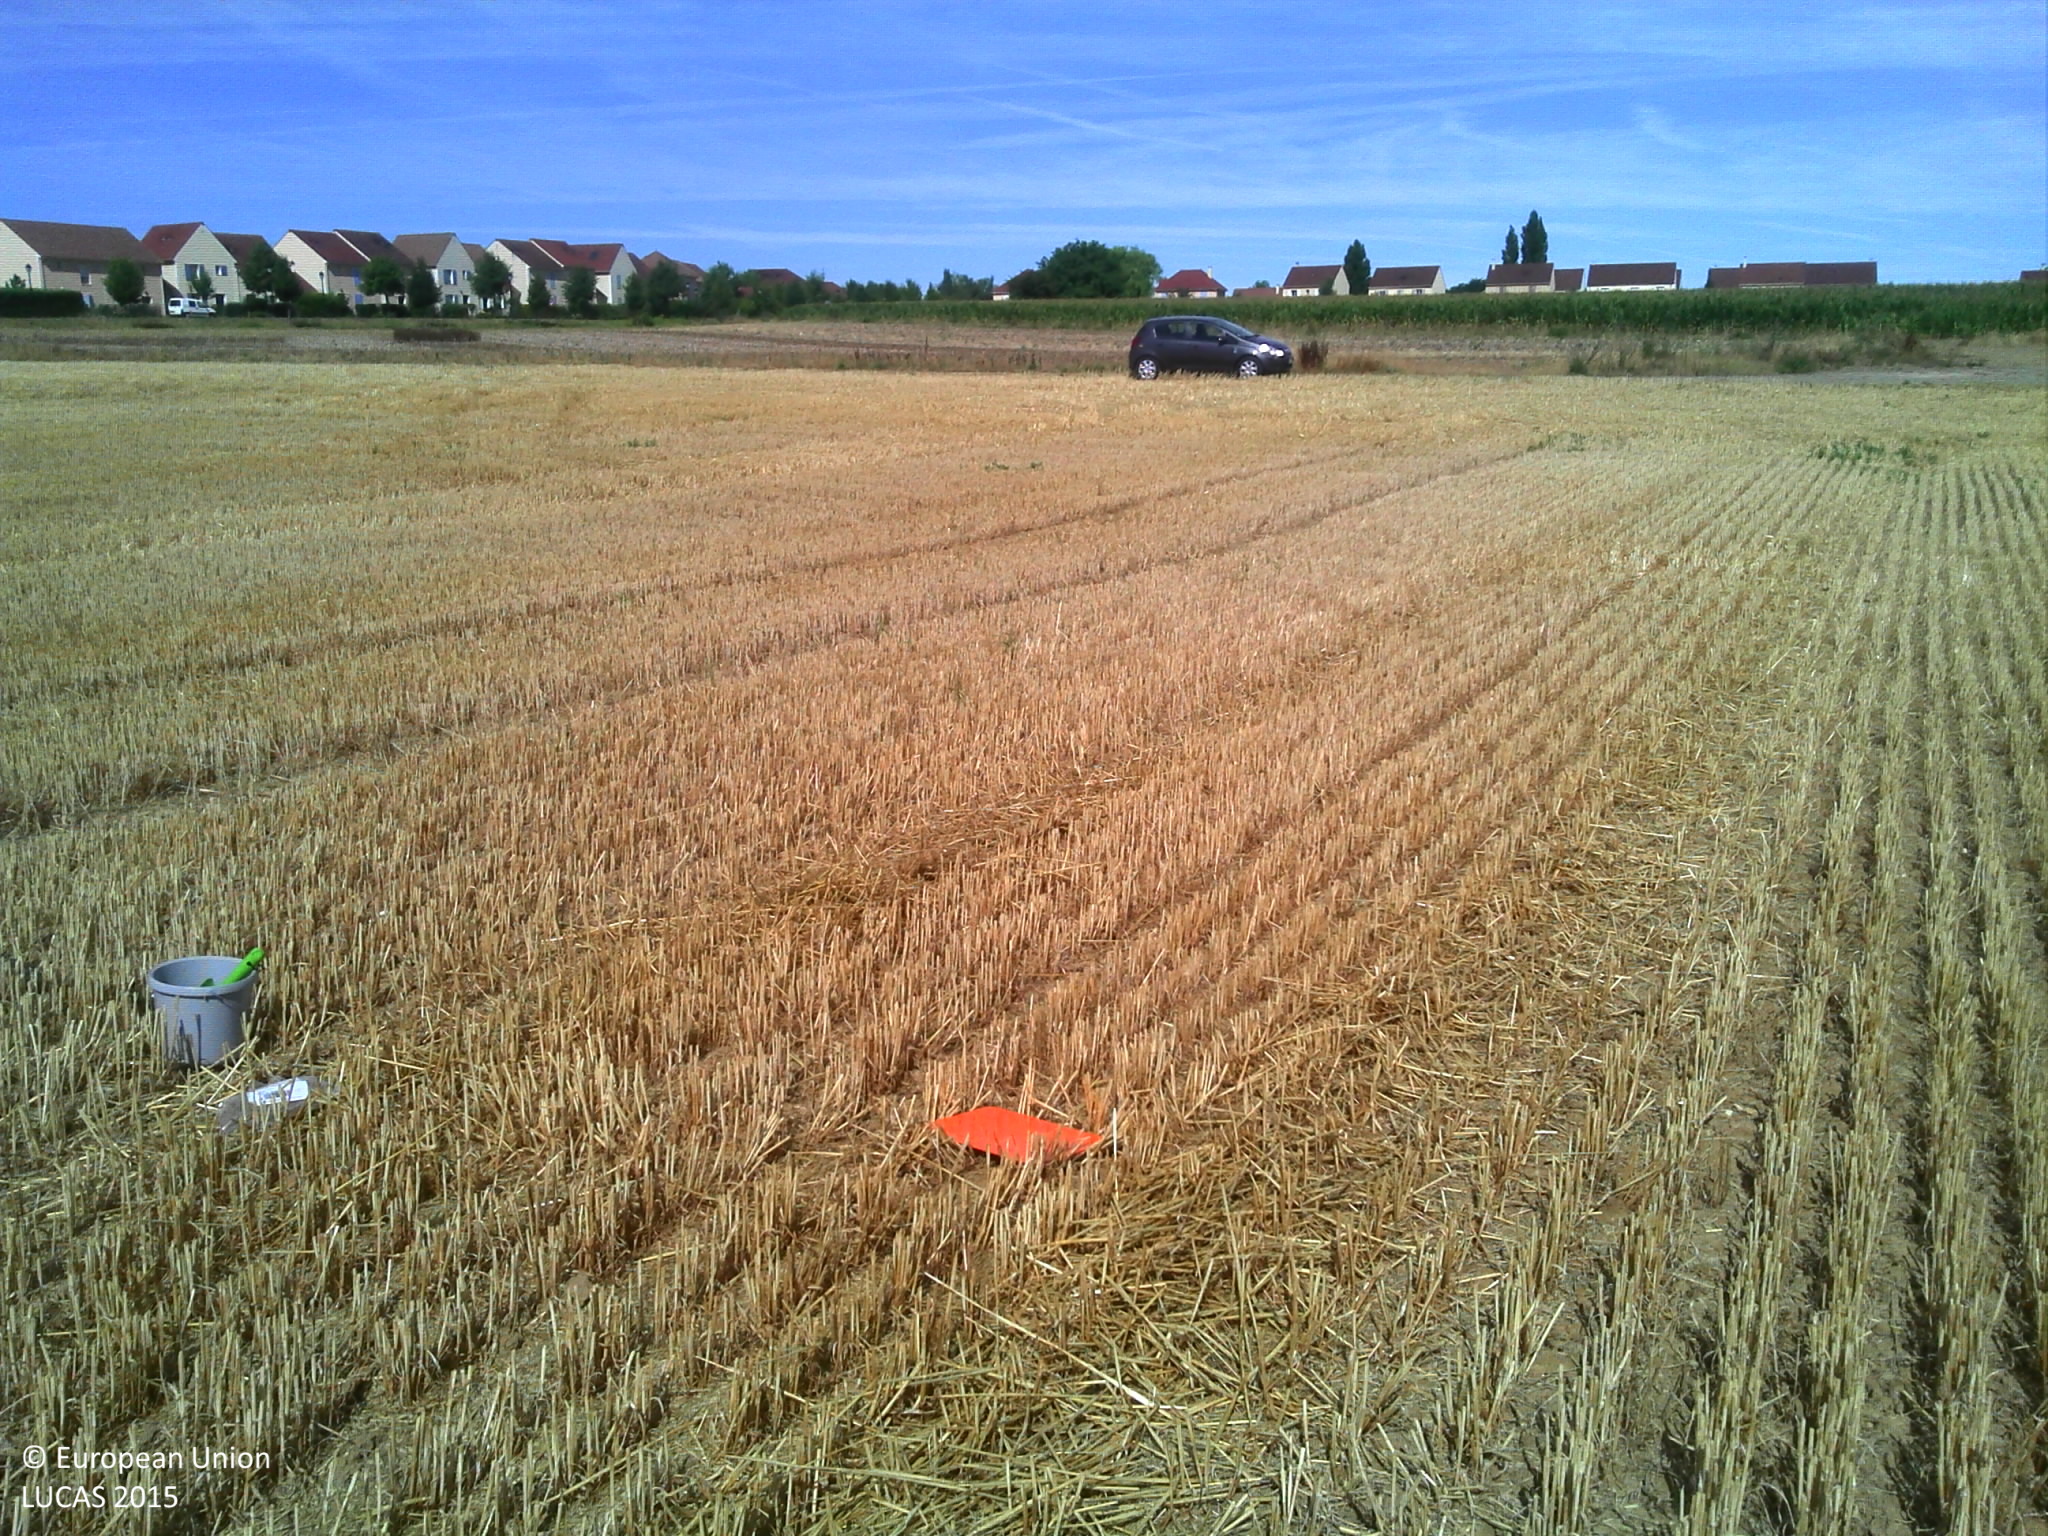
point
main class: Cropland
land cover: Common wheat
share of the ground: 10 - 25 %
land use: Agriculture (excluding fallow land and kitchen gardens)
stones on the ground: < 10 %
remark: Harvested field
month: August
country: FR
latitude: 49.0595
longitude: 2.6128
